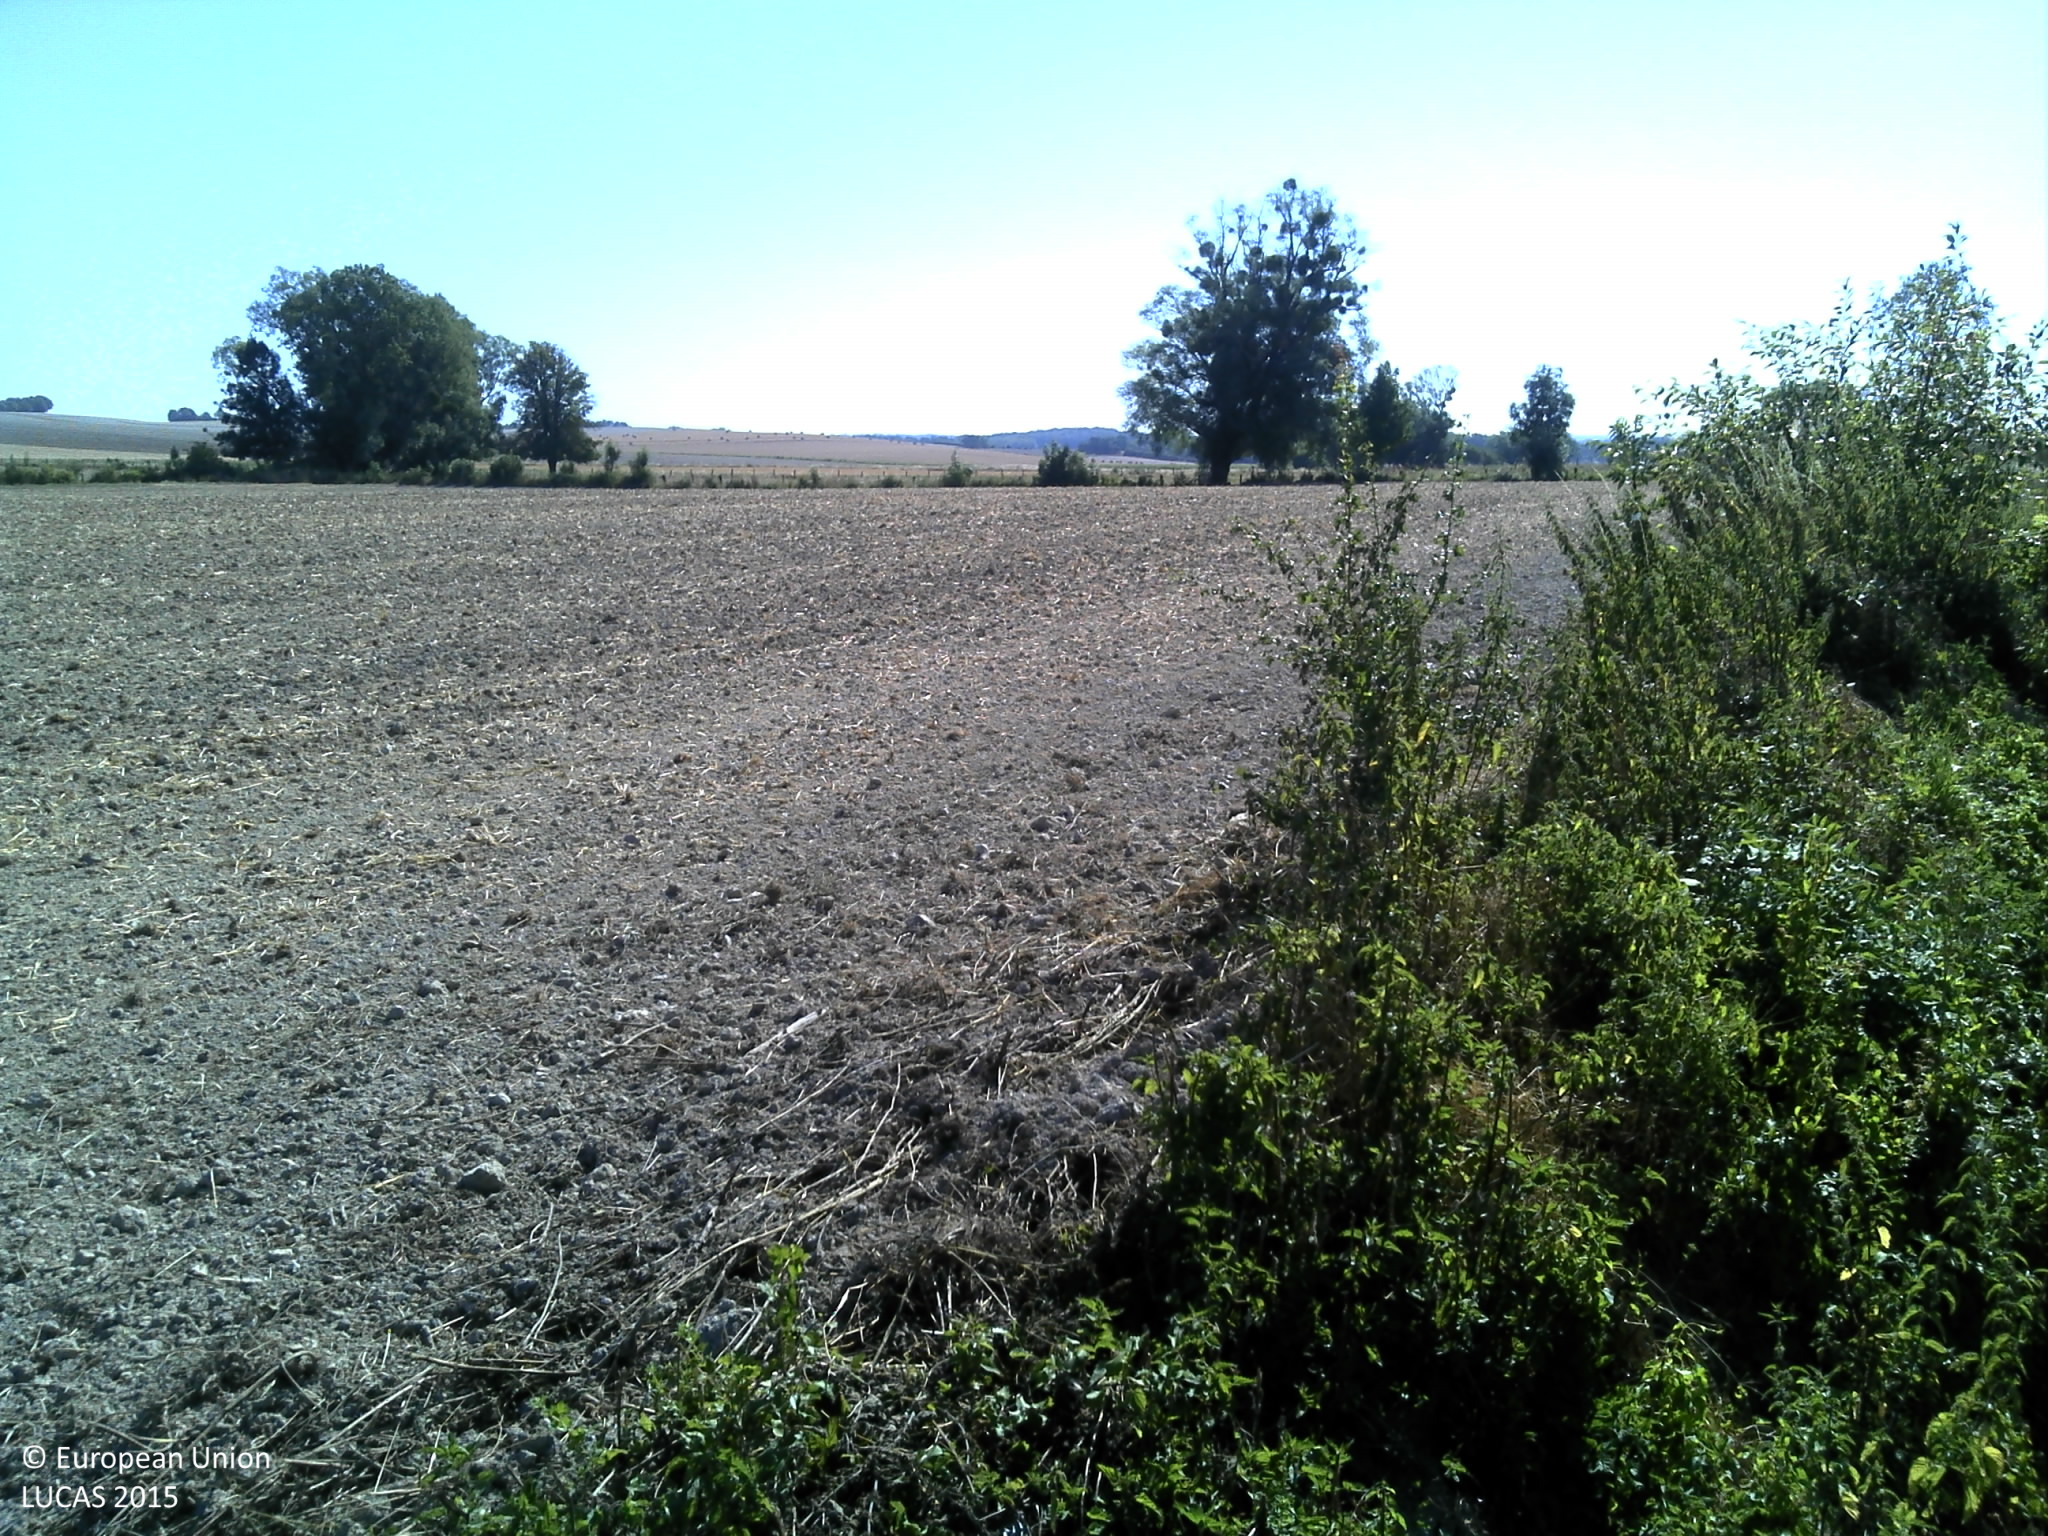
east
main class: Cropland
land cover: Common wheat
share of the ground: > 75 %
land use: Agriculture (excluding fallow land and kitchen gardens)
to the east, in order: Tracks; Grass margins; Ditches and canals; Common wheat; Ditches and canals; Lines of trees; Fences; Grassland without tree/shrub cover; Fences; Sugar beet
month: August
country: FR
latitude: 49.1645
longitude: 4.7996
